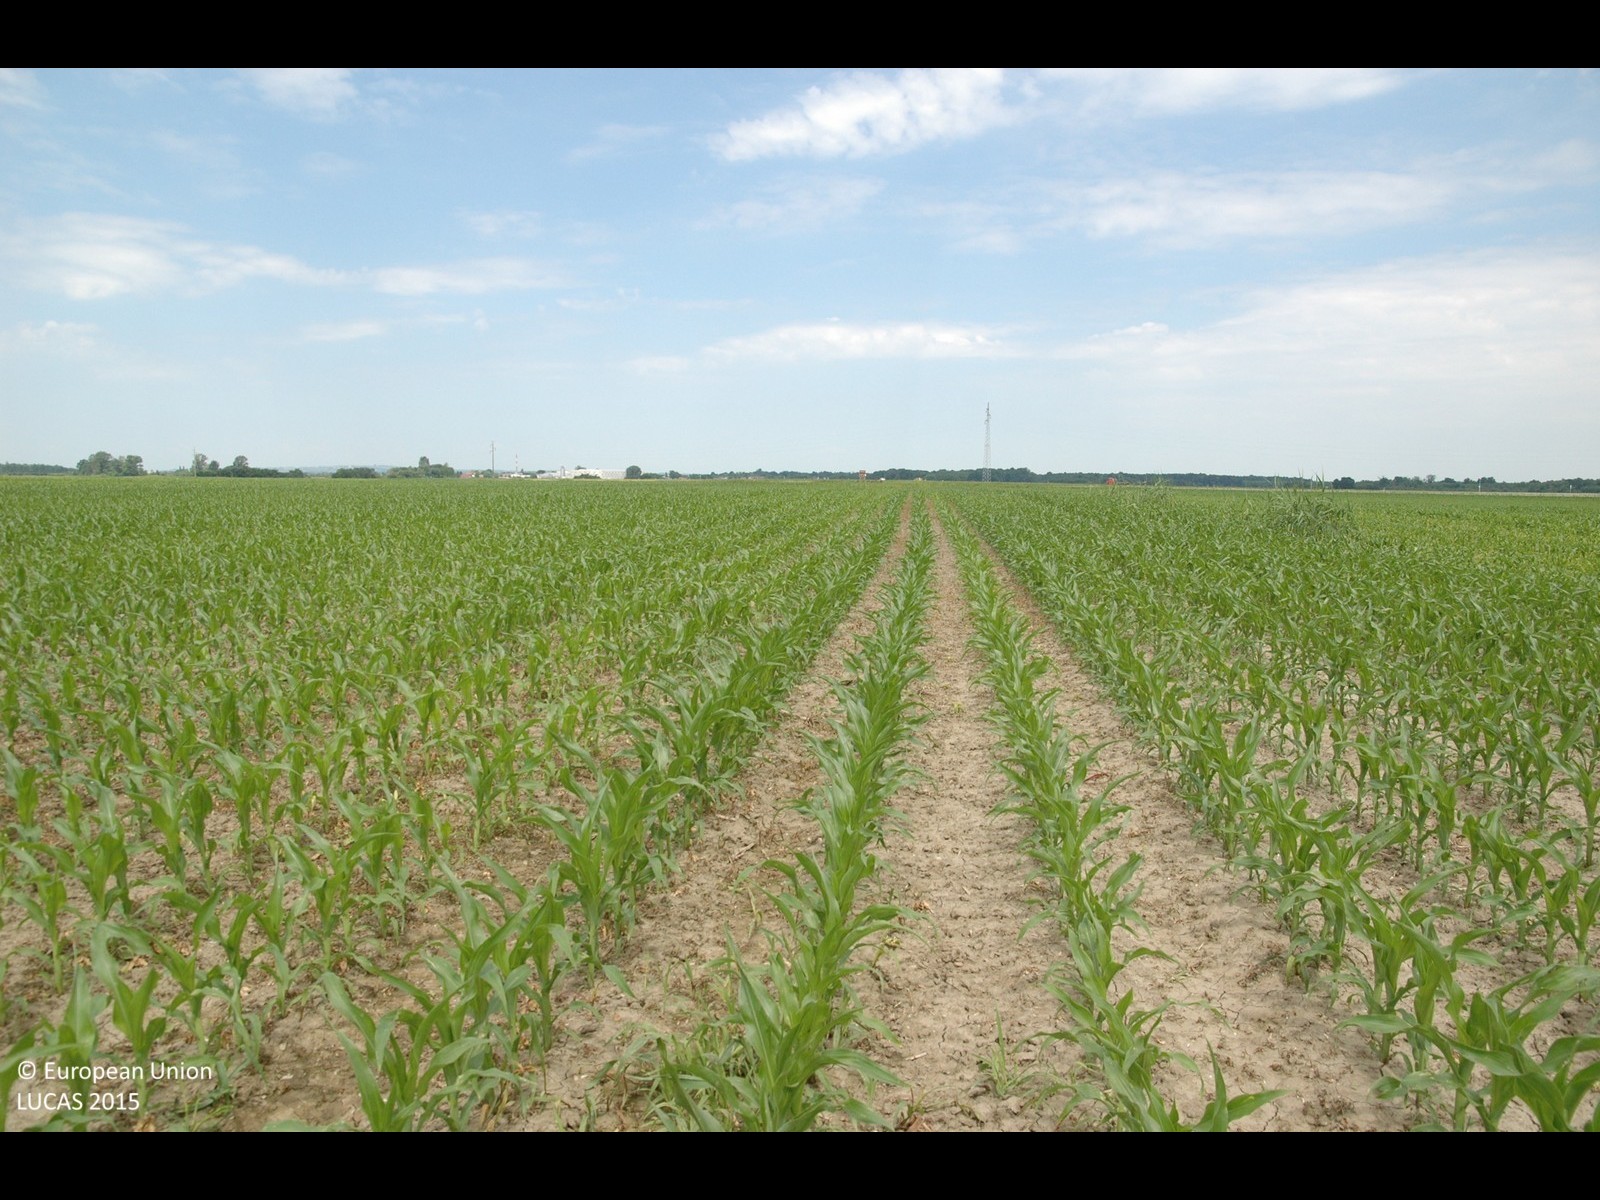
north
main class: Cropland
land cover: Maize
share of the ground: 25 - 50 %
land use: Agriculture (excluding fallow land and kitchen gardens)
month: May
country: HR
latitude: 46.3515
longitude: 16.5112
